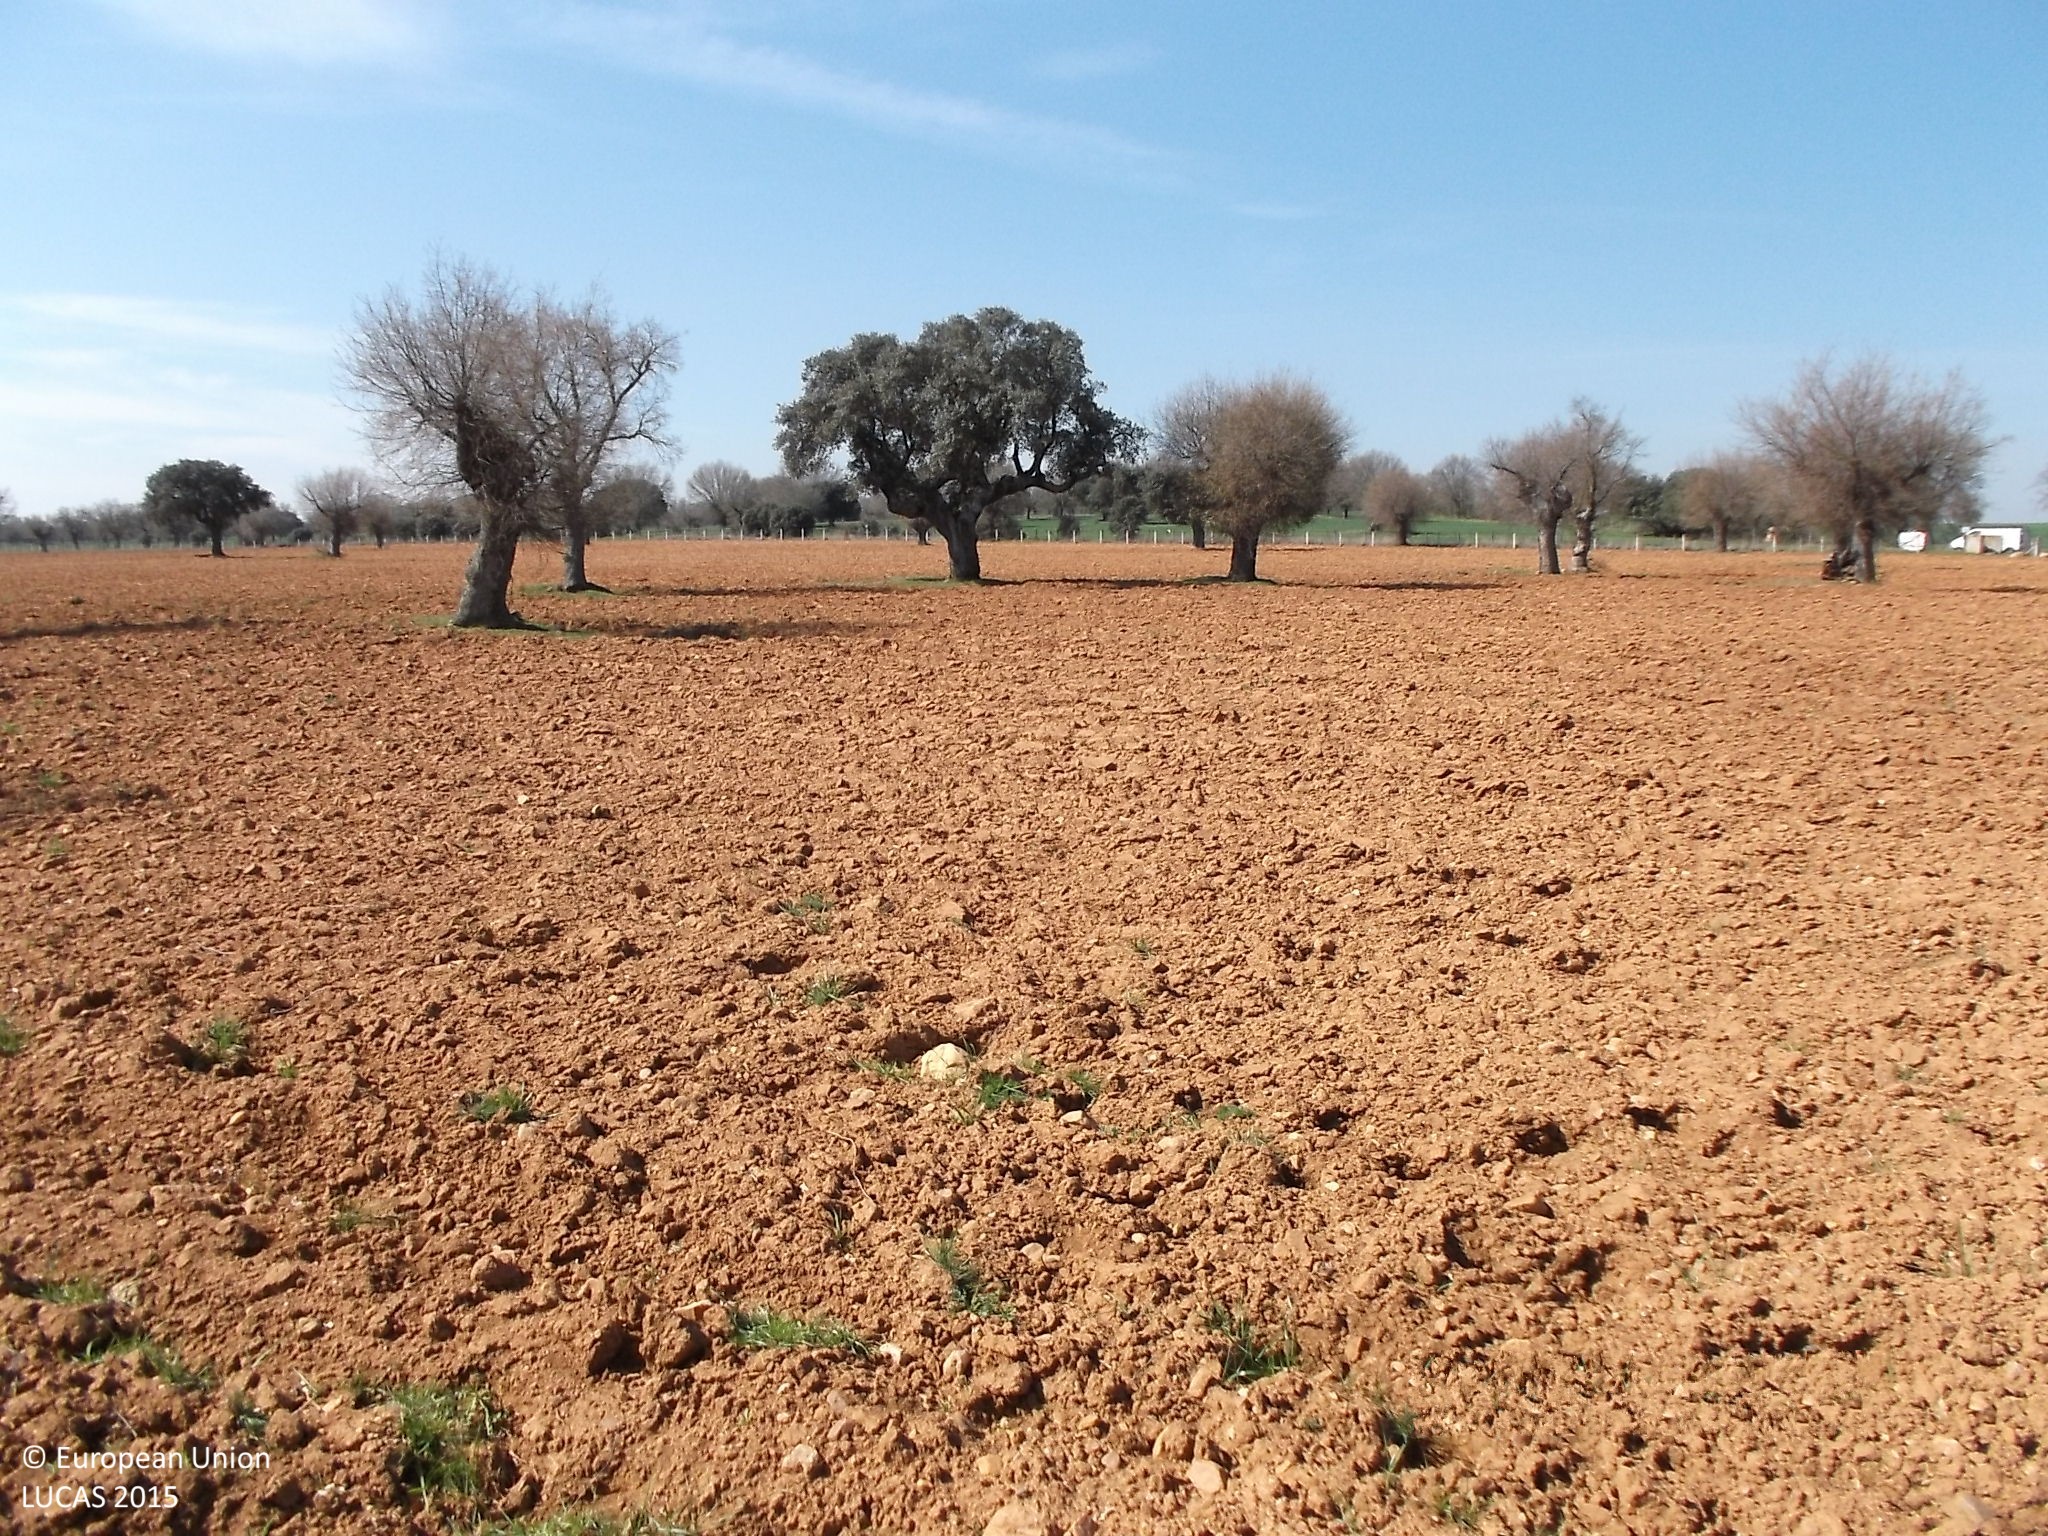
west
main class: Woodland
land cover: Broadleaved woodland
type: broadleaved evergreen forest
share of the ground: 10 - 25 %
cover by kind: unconsolidated bare surface 85 %, broadleaved forest trees 15 %
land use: Forestry
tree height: < 5 m
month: April
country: ES
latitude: 40.8568
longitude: -5.8934
